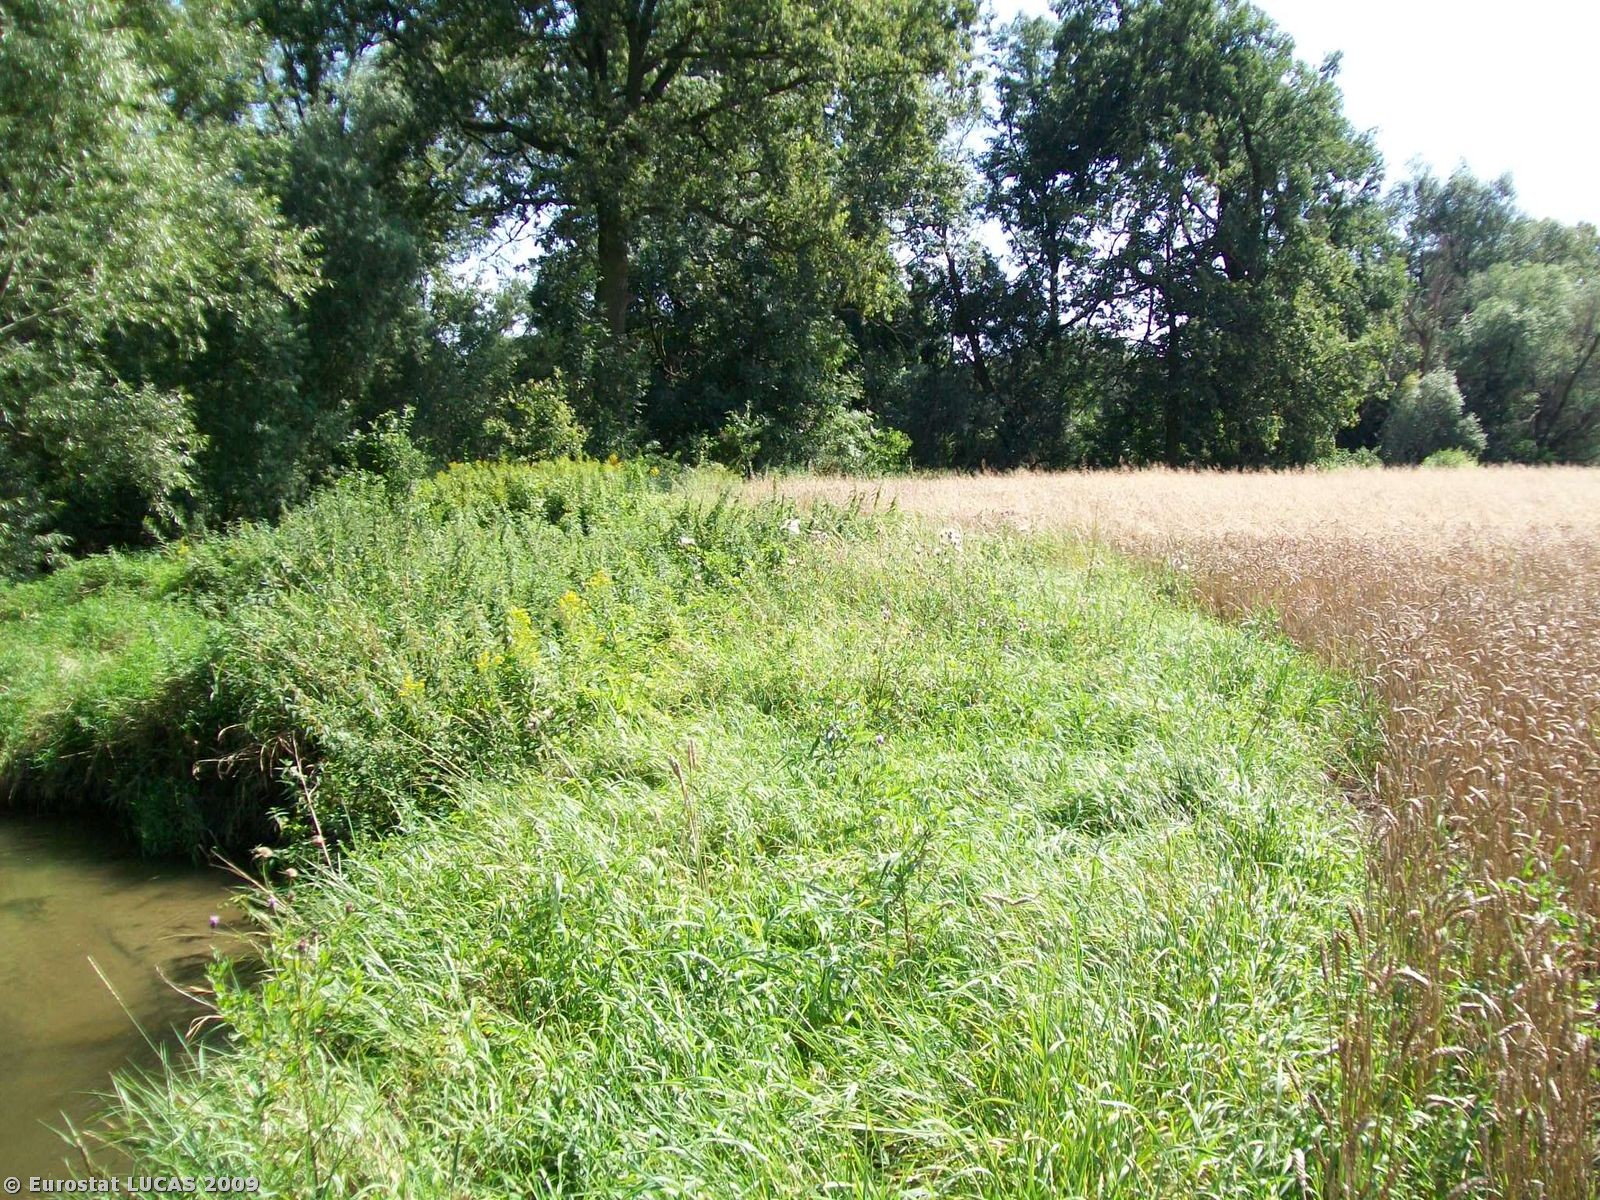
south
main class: Cropland
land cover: Common wheat
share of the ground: > 75 %
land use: Agriculture (excluding fallow land and kitchen gardens)
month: August
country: PL
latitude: 51.0484
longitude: 16.7561
